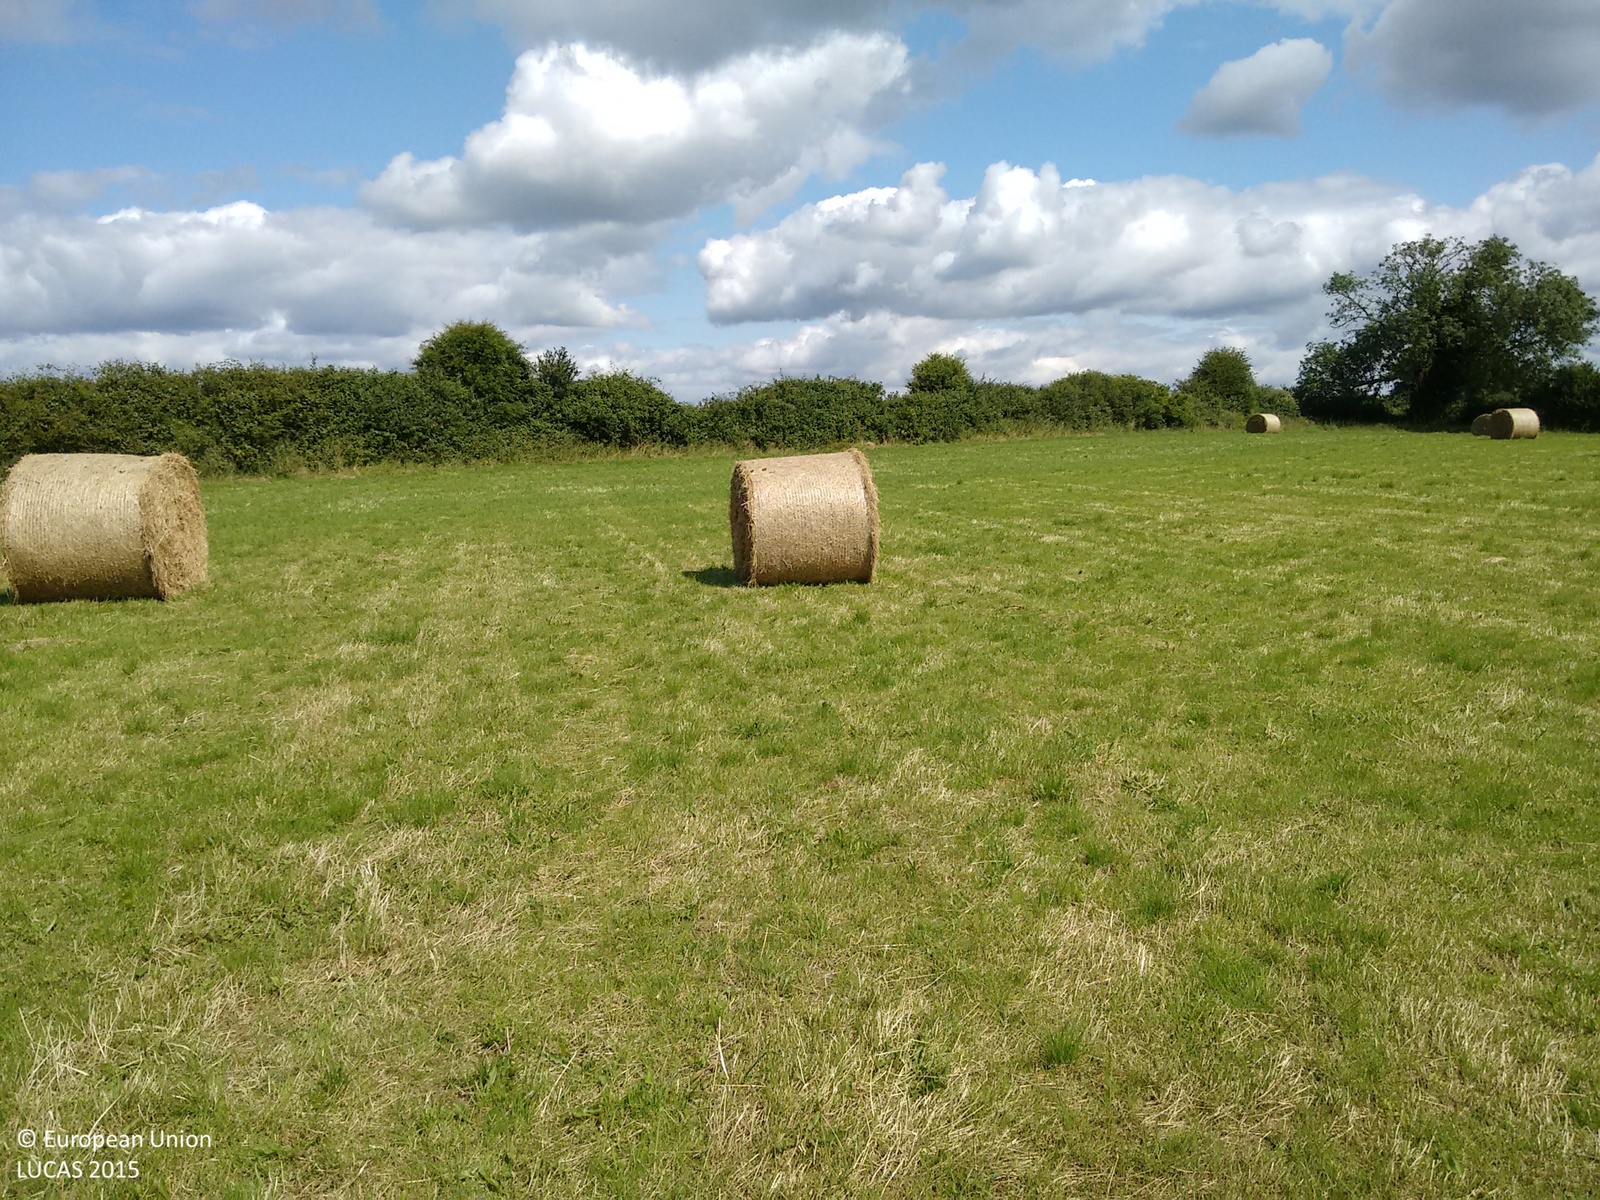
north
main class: Grassland
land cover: Grassland without tree/shrub cover
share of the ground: > 75 %
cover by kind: herbaceous plants 100 %
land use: Agriculture (excluding fallow land and kitchen gardens)
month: July
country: IE
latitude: 53.5585
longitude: -7.9413
